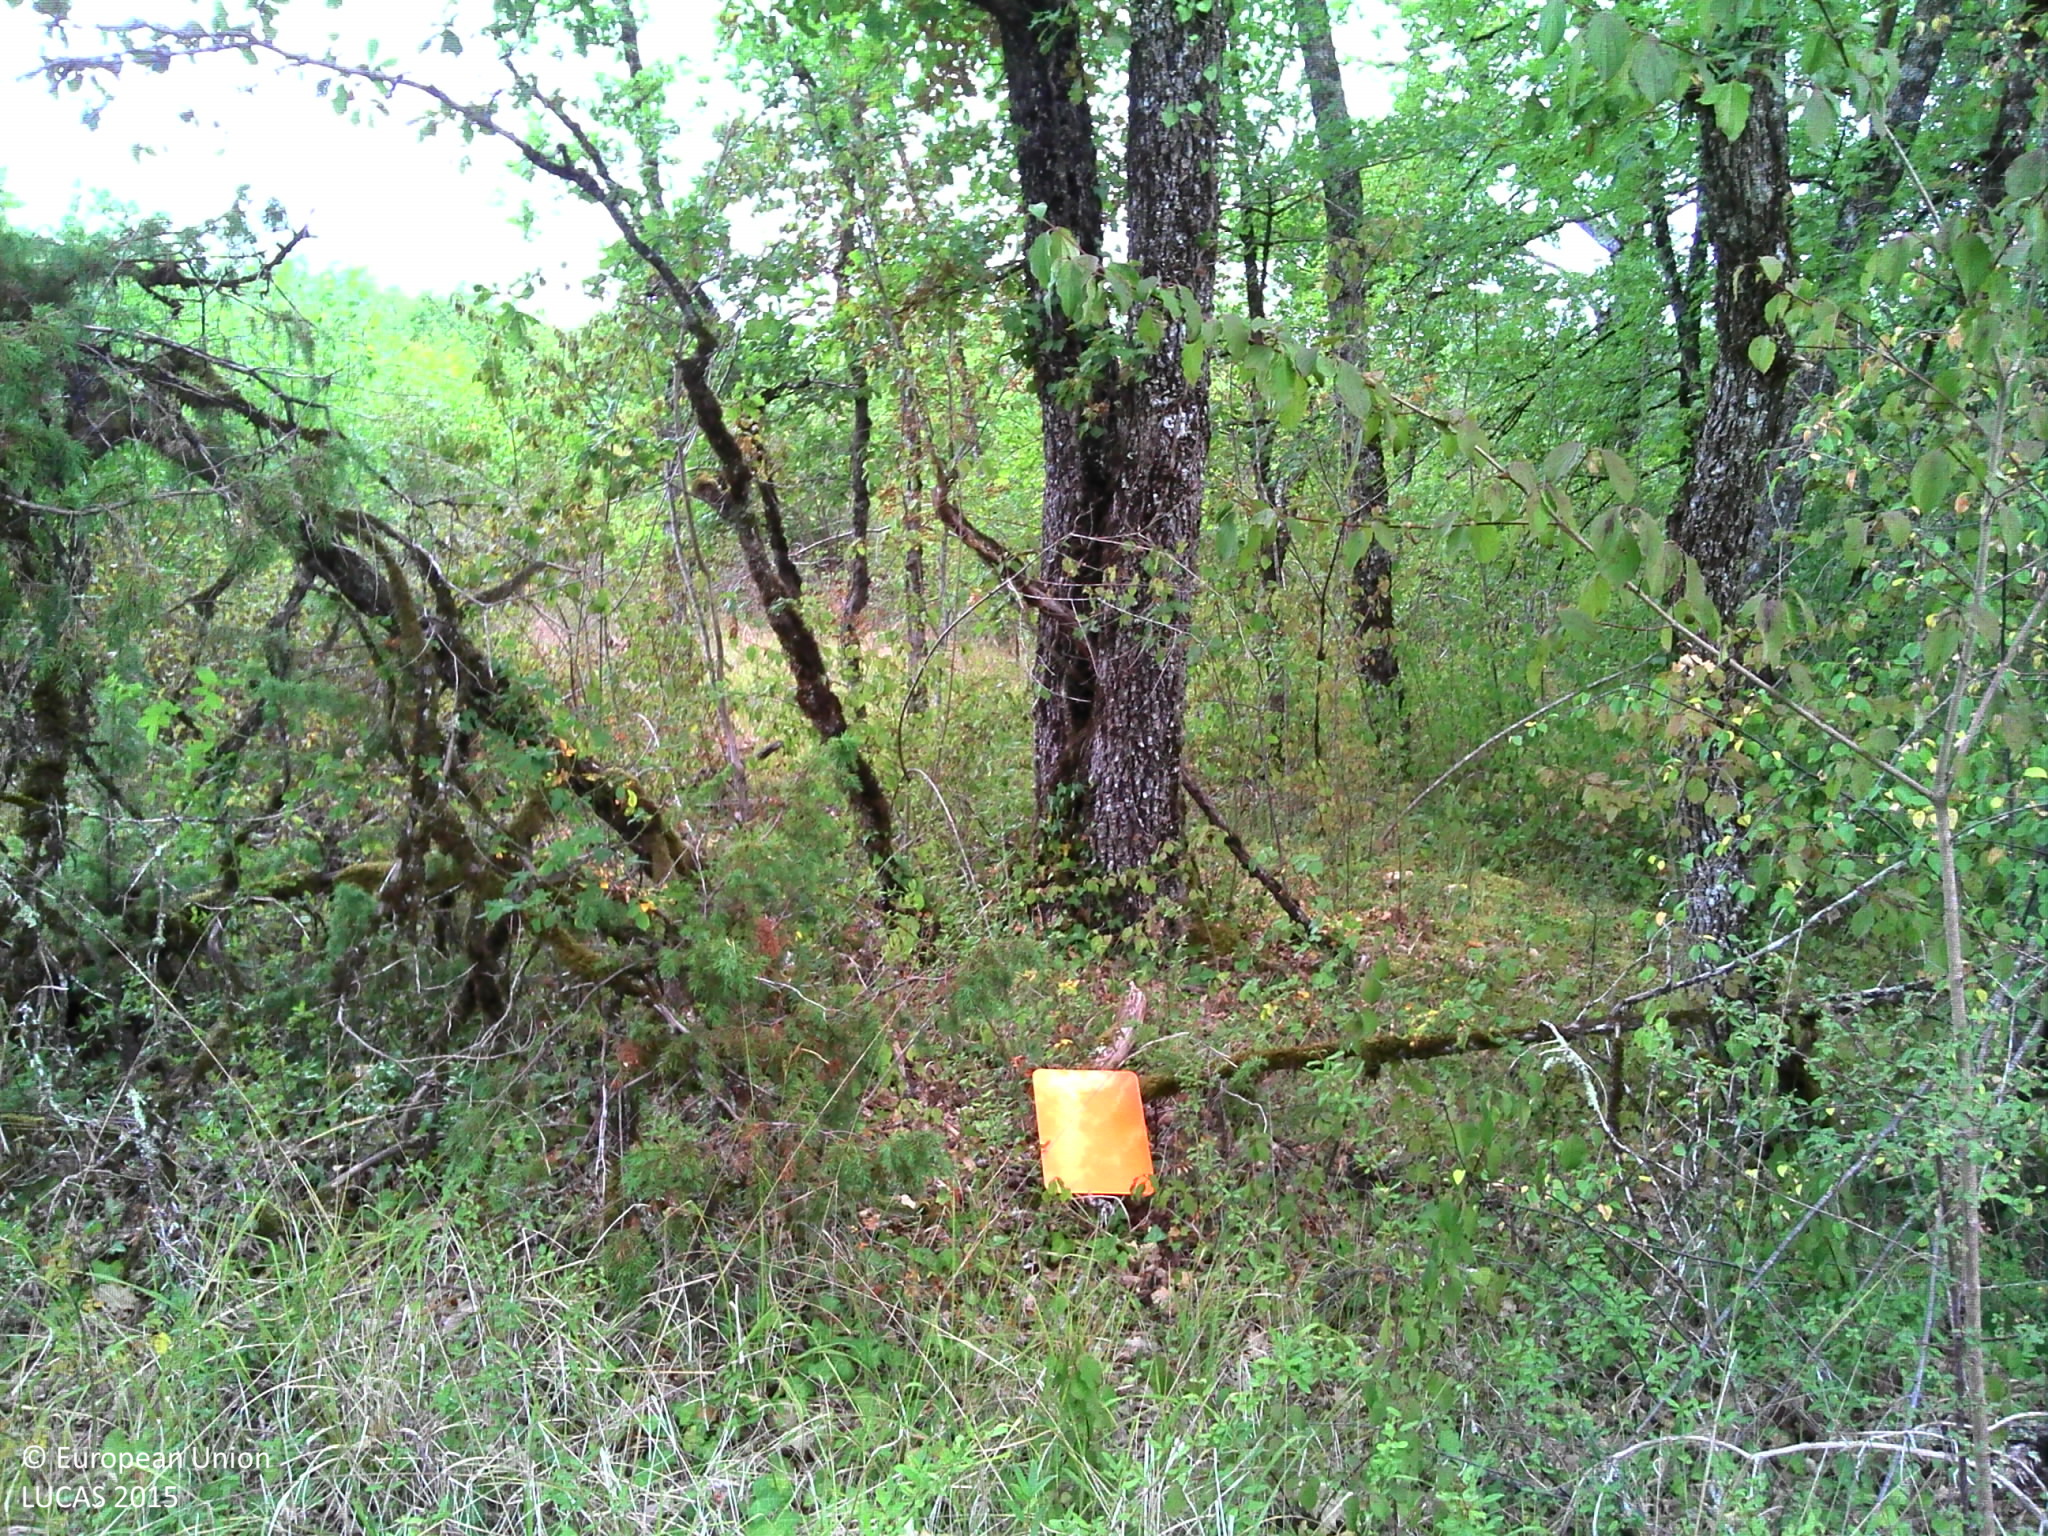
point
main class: Woodland
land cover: Broadleaved woodland
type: acidophilous oak and oak-birch forest
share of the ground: > 75 %
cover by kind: broadleaved forest trees 65 %, herbaceous plants 25 %, coniferous forest trees 5 %, shrubs 5 %
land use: Forestry
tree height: > 5 m
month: July
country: FR
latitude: 45.0106
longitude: 1.4309
